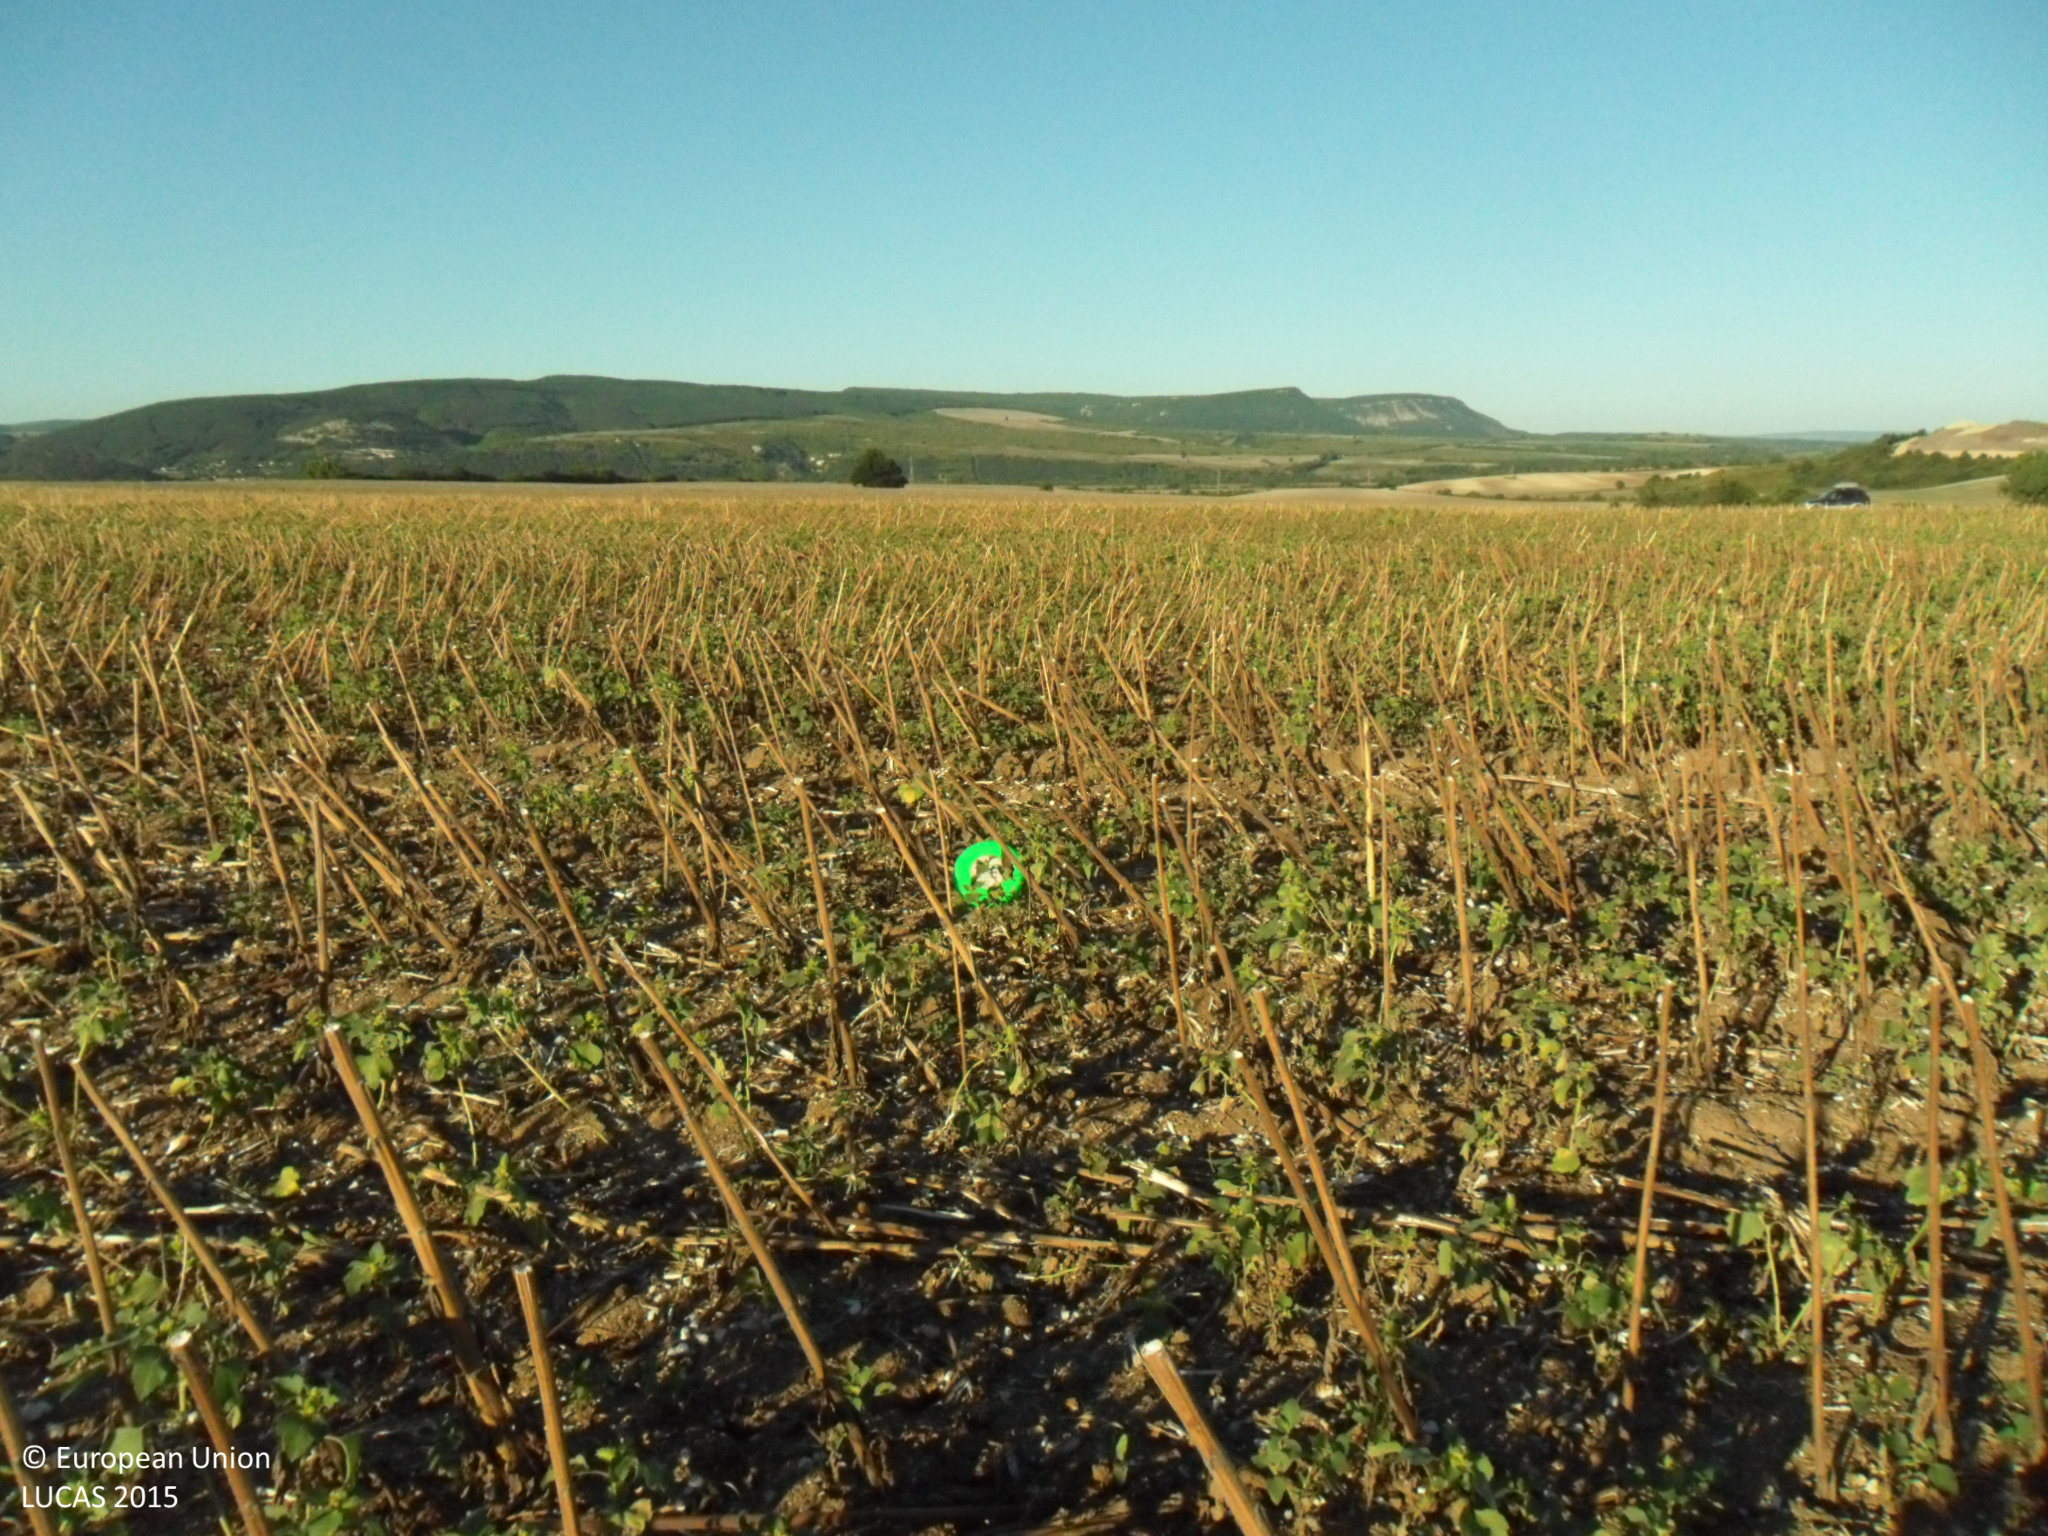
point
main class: Cropland
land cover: Sunflower
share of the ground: 10 - 25 %
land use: Agriculture (excluding fallow land and kitchen gardens)
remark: Harvested field
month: September
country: BG
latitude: 43.1927
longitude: 26.7816
